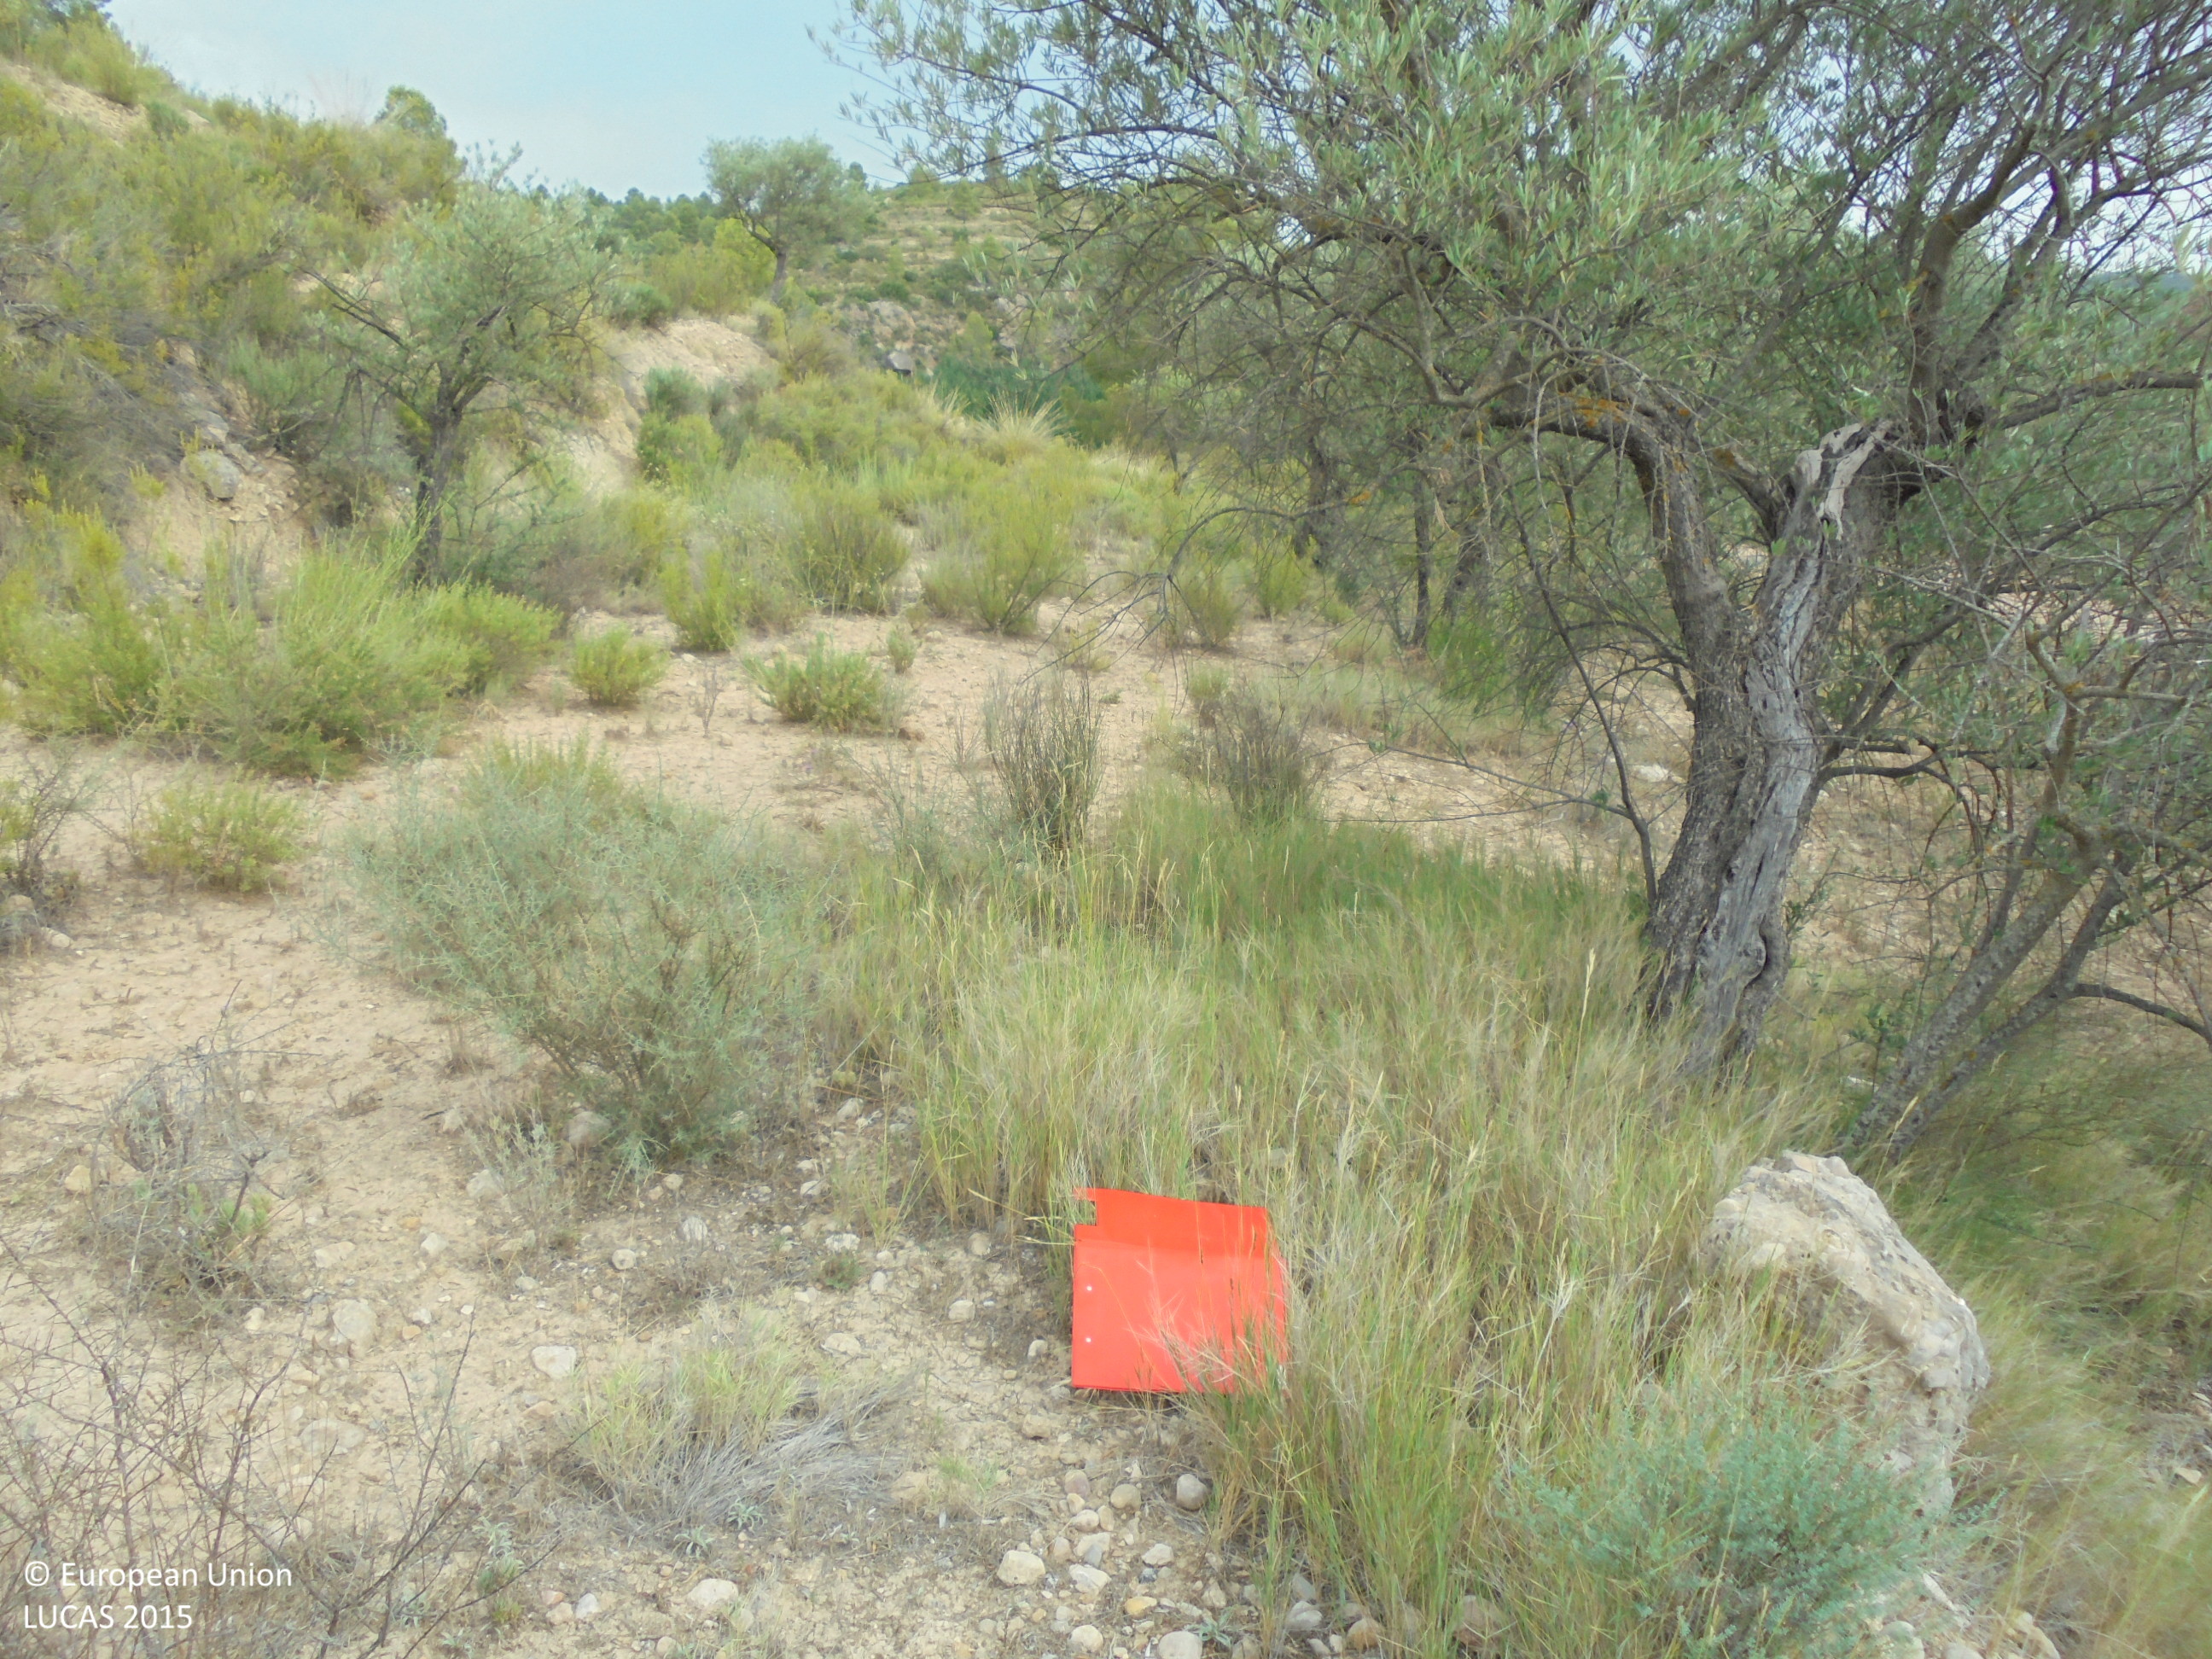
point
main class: Cropland
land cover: Olive groves
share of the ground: 25 - 50 %
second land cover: Shrubland without tree cover
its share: 25 - 50 %
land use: Abandoned areas
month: August
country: ES
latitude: 39.1486
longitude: -1.0474
